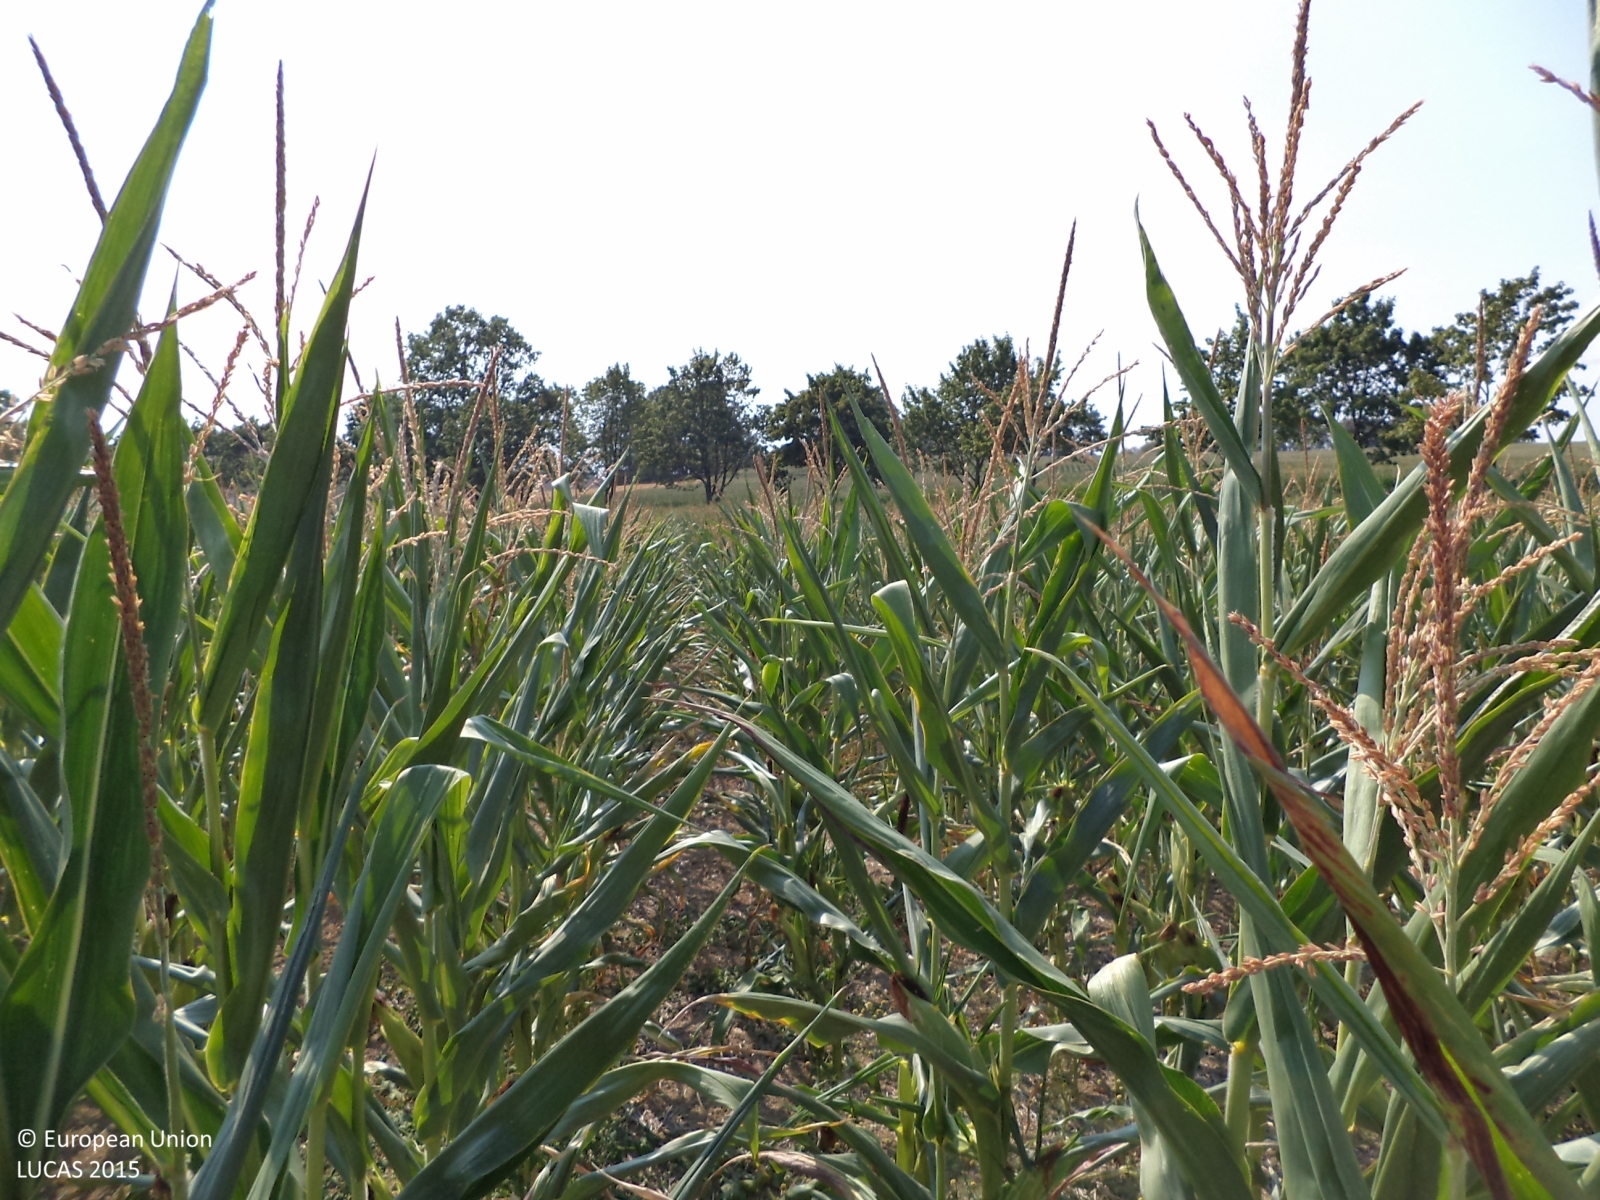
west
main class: Cropland
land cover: Maize
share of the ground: > 75 %
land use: Agriculture (excluding fallow land and kitchen gardens)
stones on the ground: < 10 %
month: August
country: CZ
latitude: 49.5238
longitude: 14.3805
